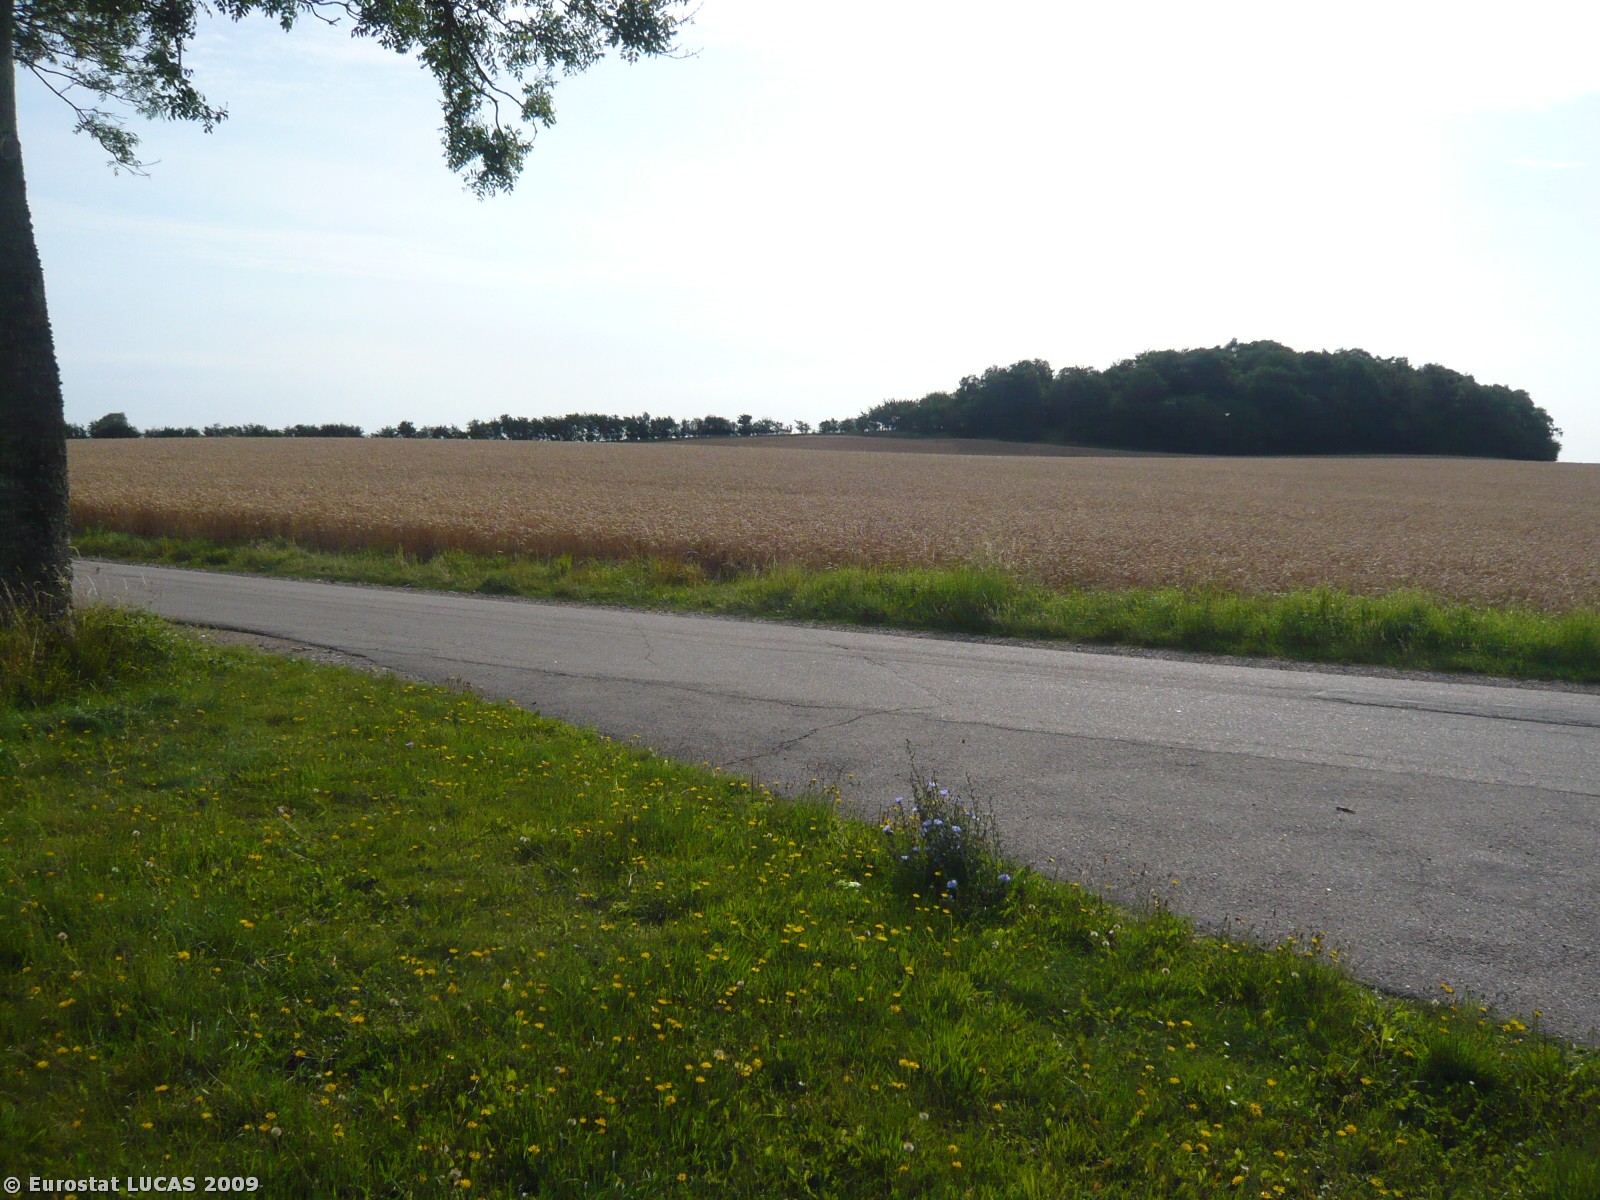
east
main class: Cropland
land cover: Barley
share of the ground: > 75 %
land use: Agriculture (excluding fallow land and kitchen gardens)
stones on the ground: < 10 %
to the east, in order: Barley; Lines of trees; Paved roads, cycling and walking lanes; Common wheat
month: August
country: DK
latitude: 55.9897
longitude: 12.1620
